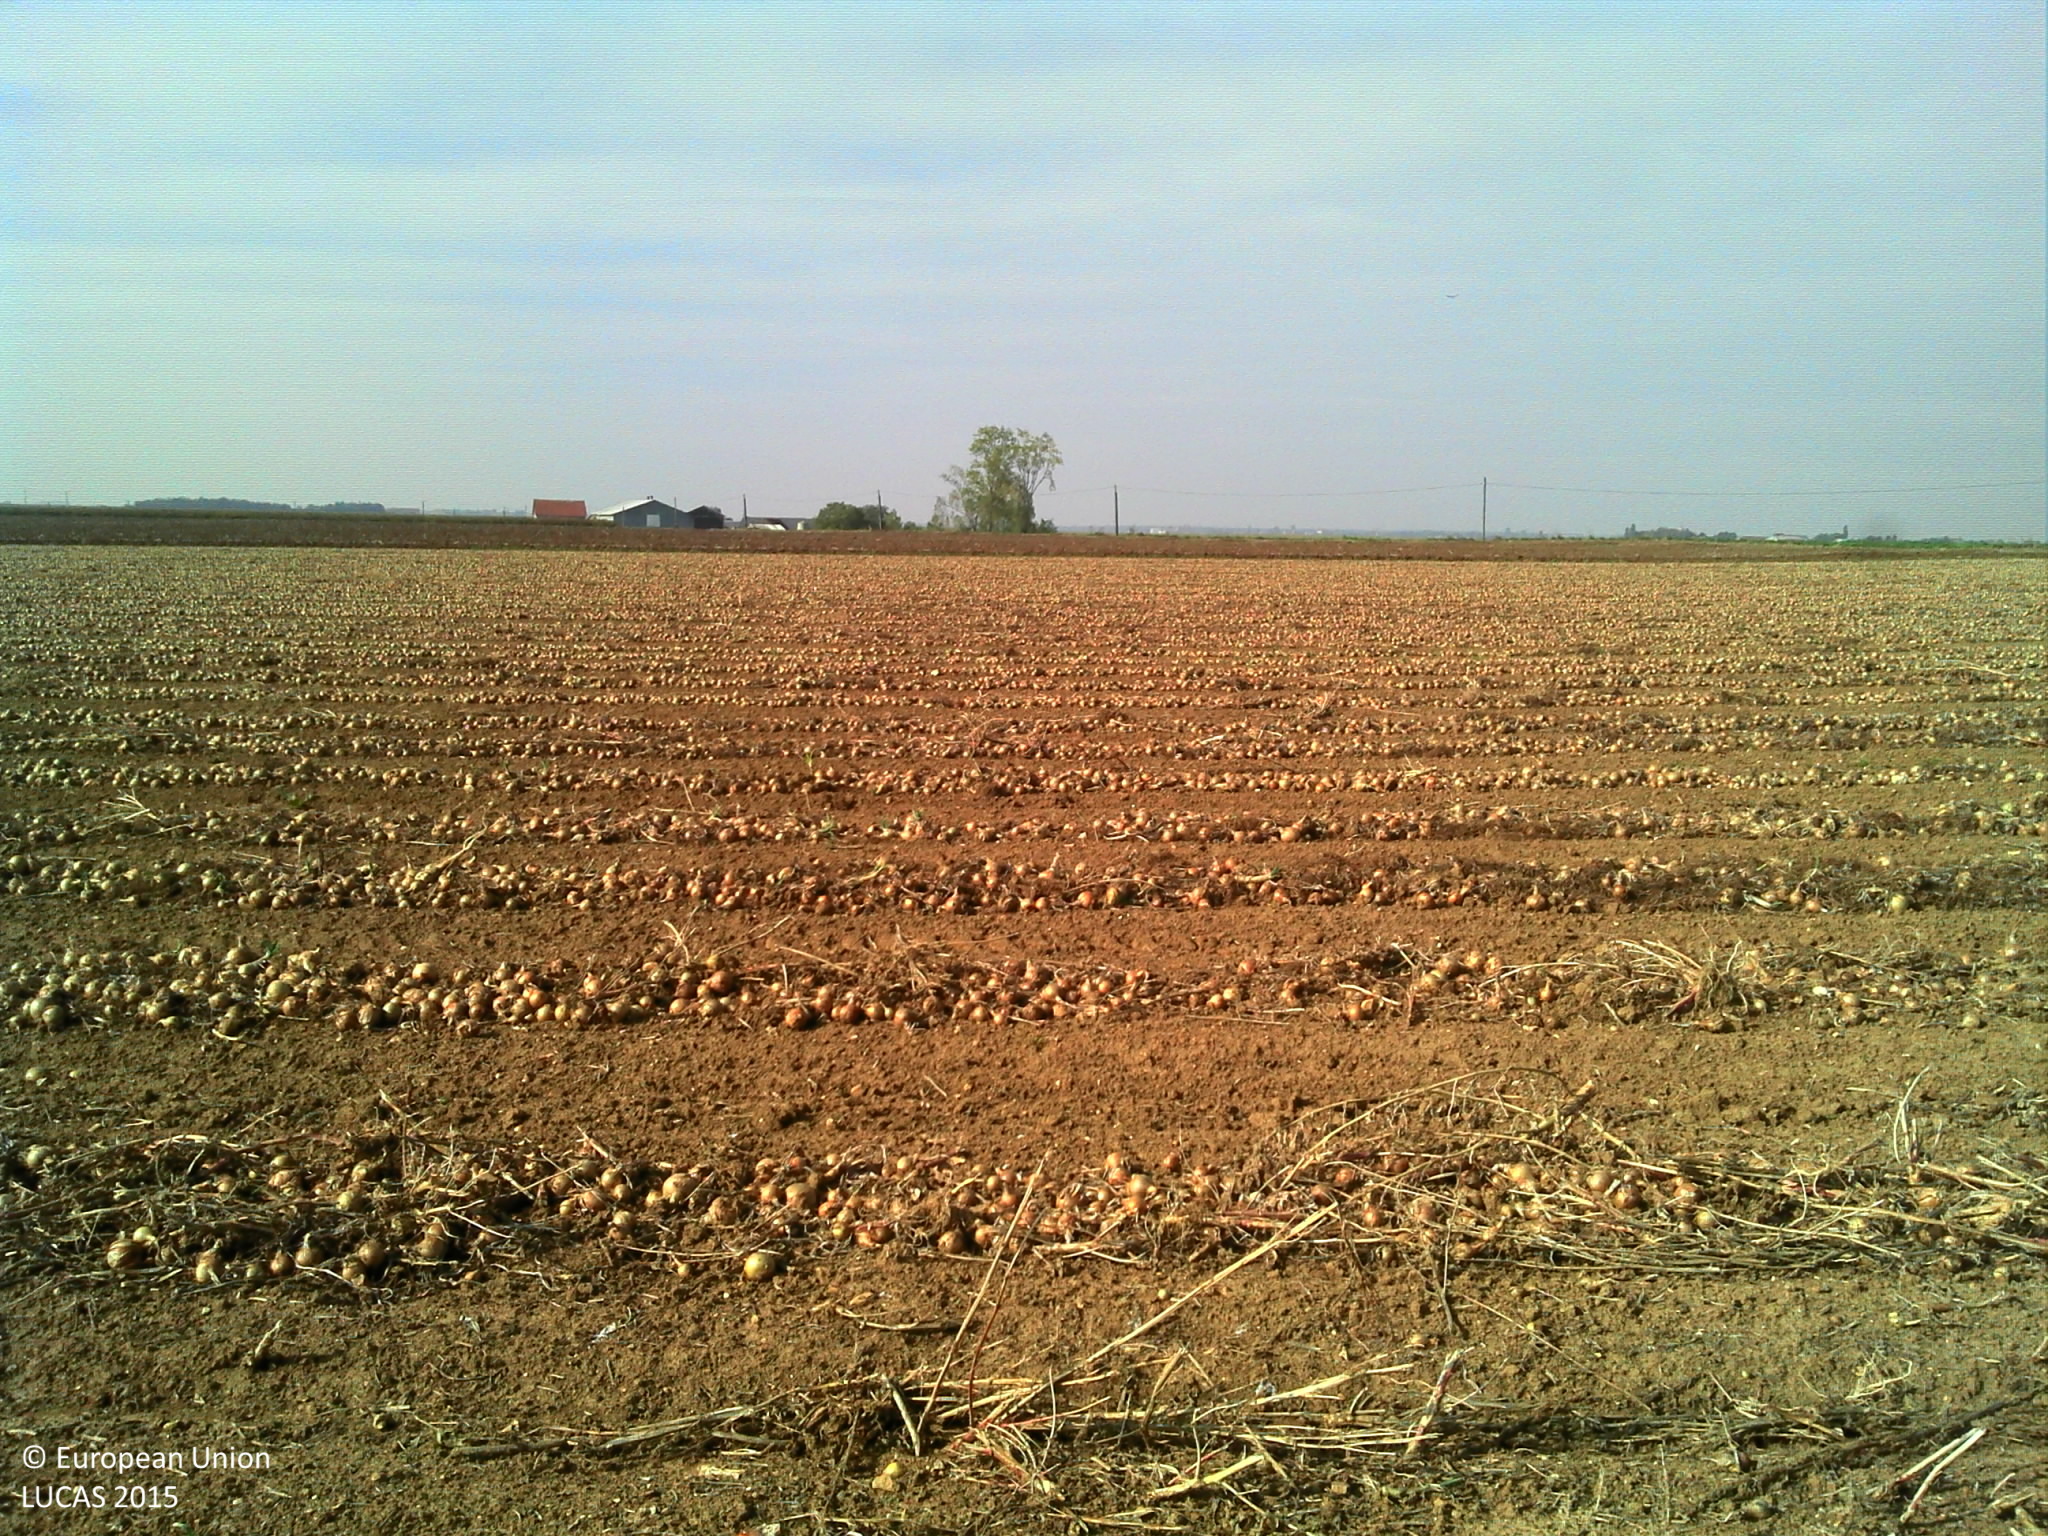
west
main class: Cropland
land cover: Other root crops
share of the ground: 25 - 50 %
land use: Agriculture (excluding fallow land and kitchen gardens)
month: October
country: FR
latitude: 47.8123
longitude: 1.3706
